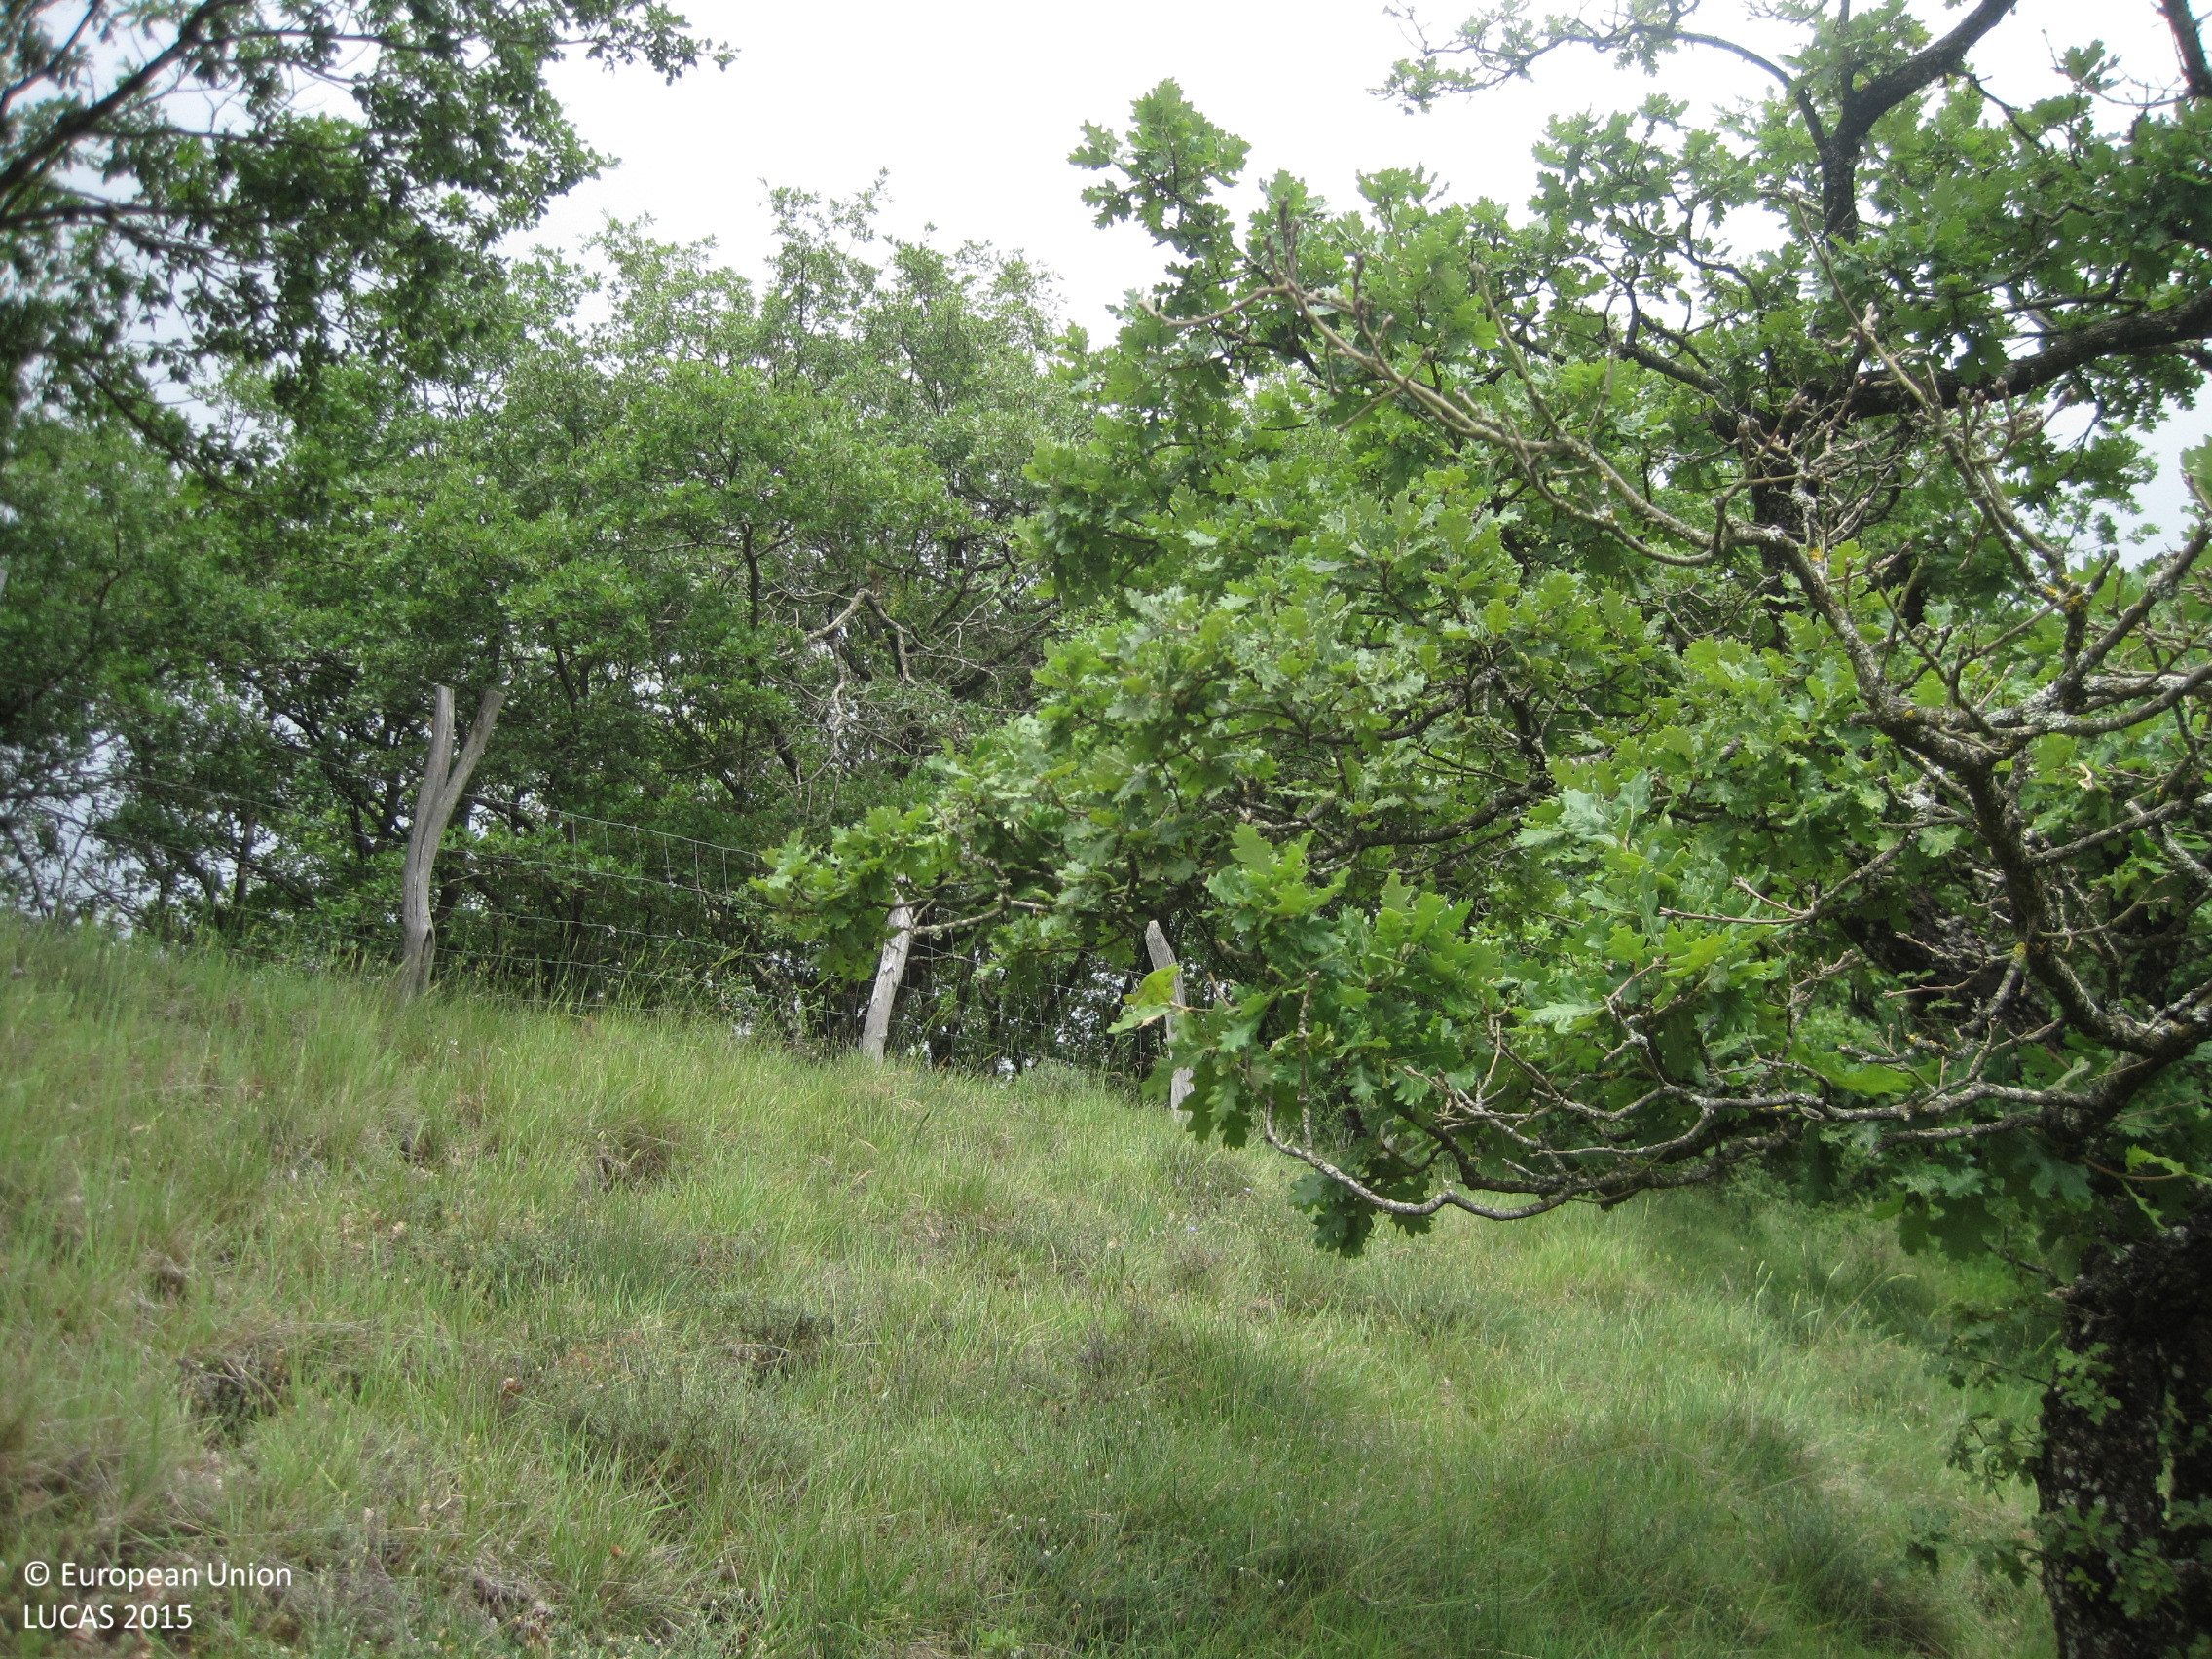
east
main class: Grassland
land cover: Grassland with sparse tree/shrub cover
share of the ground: > 75 %
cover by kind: herbaceous plants 95 %, broadleaved forest trees 5 %
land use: Agriculture (excluding fallow land and kitchen gardens)
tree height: < 5 m
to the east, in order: Grassland with sparse tree/shrub cover; Fences; Broadleaved woodland; Fences; Pine dominated coniferous woodland; Grassland without tree/shrub cover
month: June
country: ES
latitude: 42.8960
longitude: -1.7605
